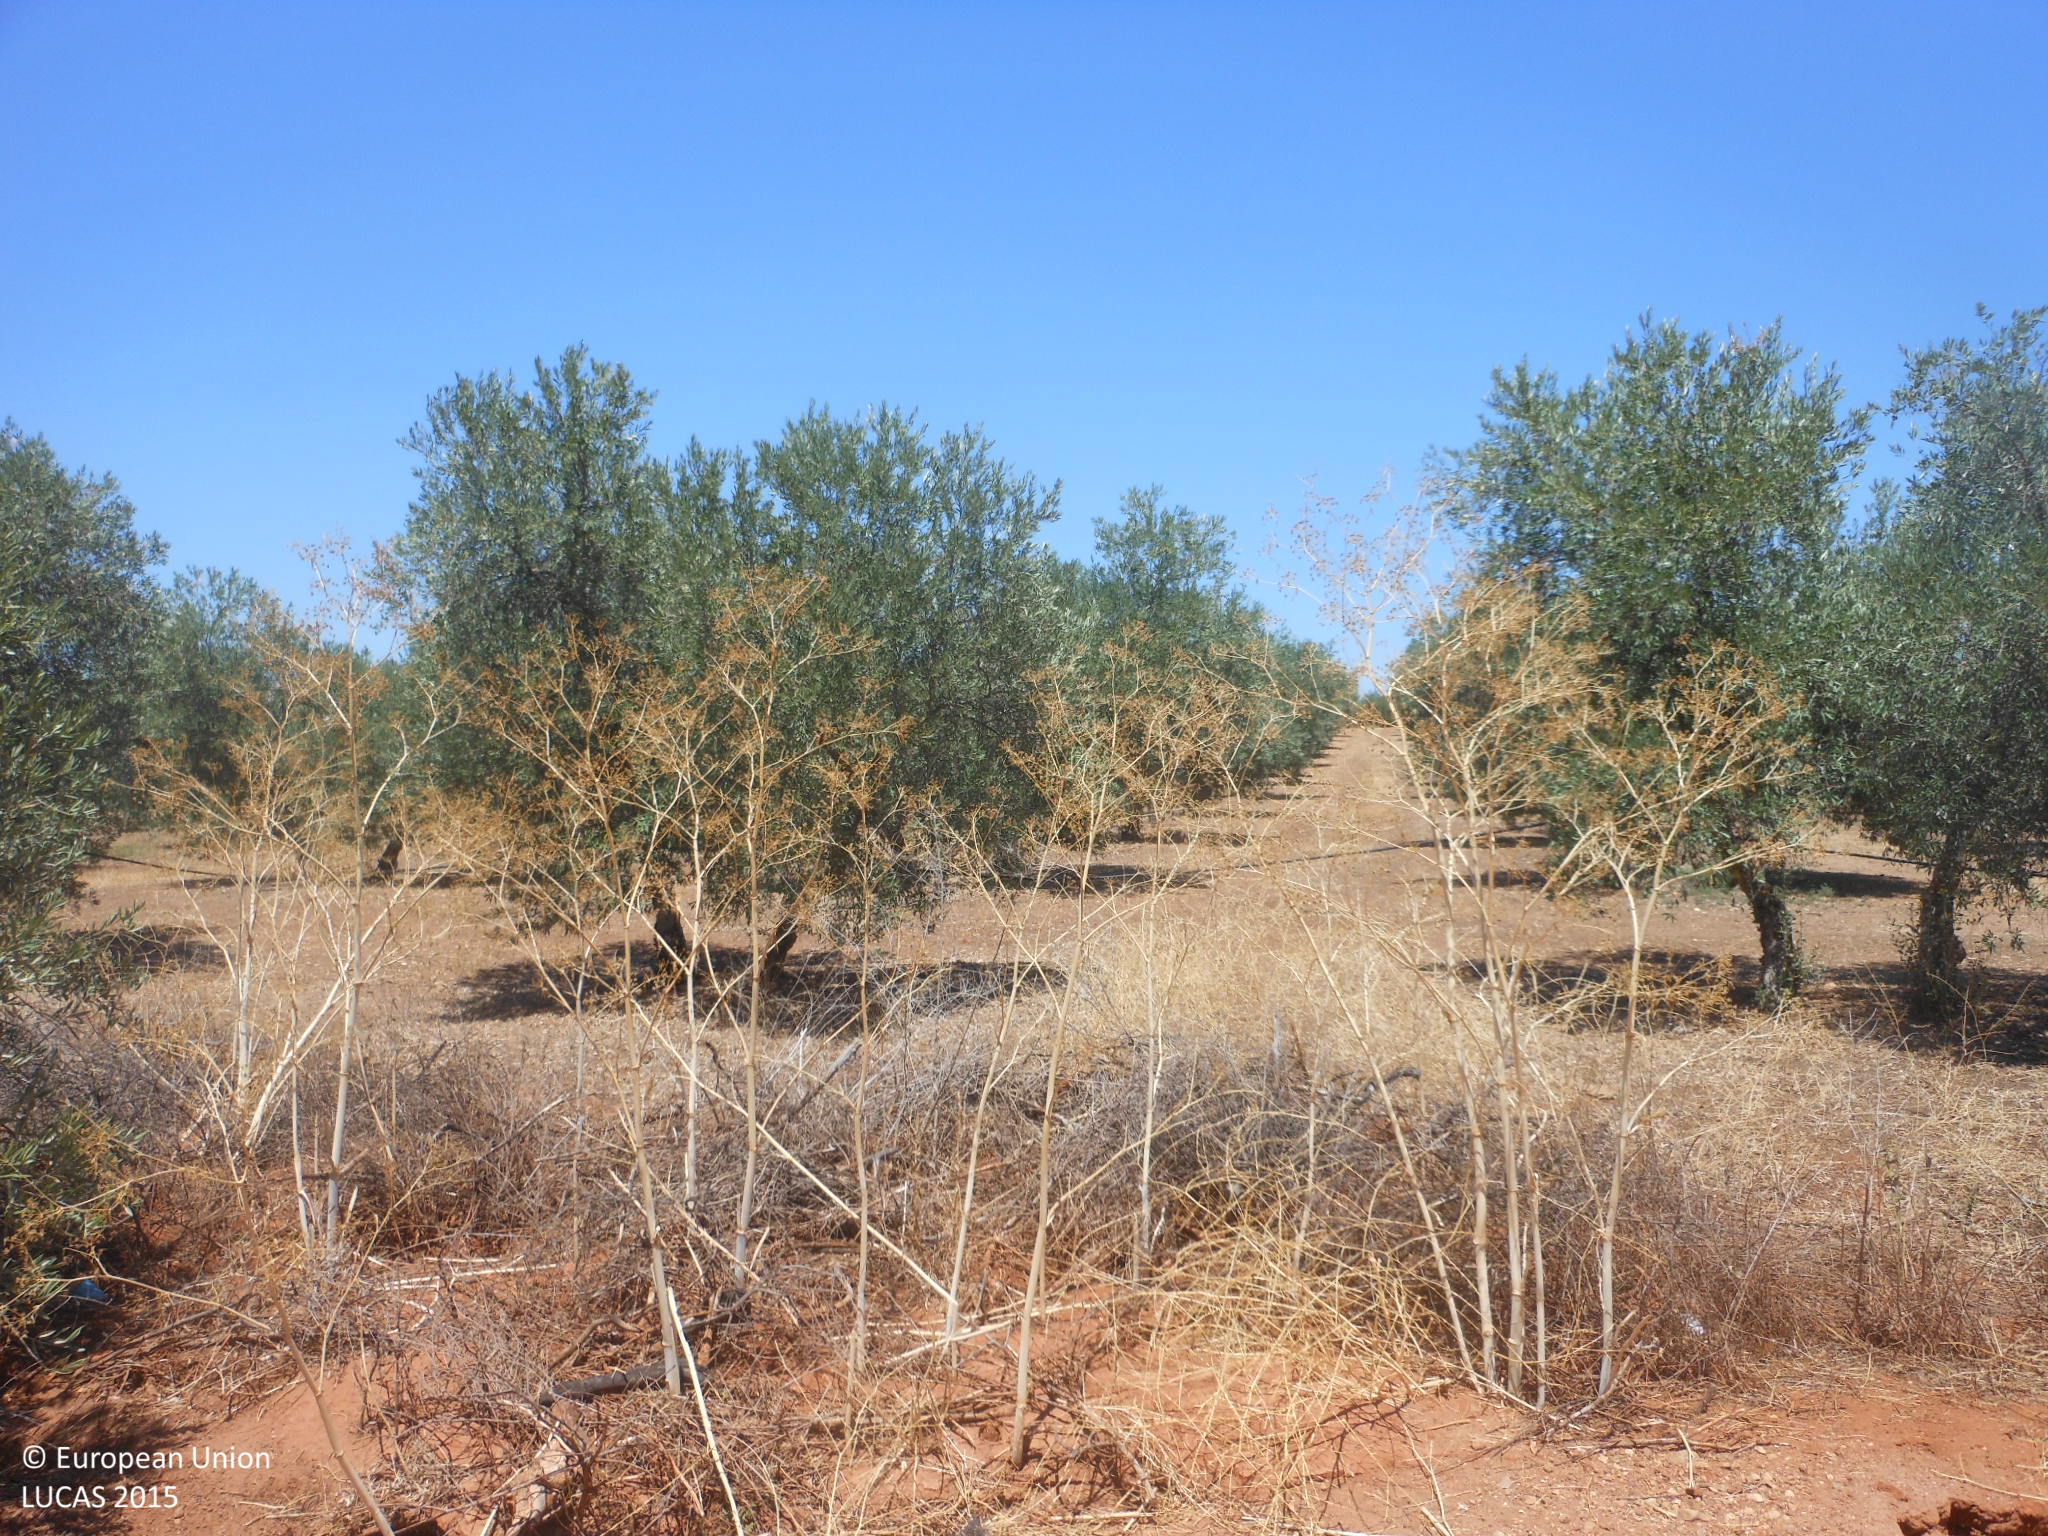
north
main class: Cropland
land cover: Olive groves
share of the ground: 50 - 75 %
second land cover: Spontaneously vegetated surfaces
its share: 10 - 25 %
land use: Agriculture (excluding fallow land and kitchen gardens)
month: July
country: ES
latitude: 37.2690
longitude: -5.3366
